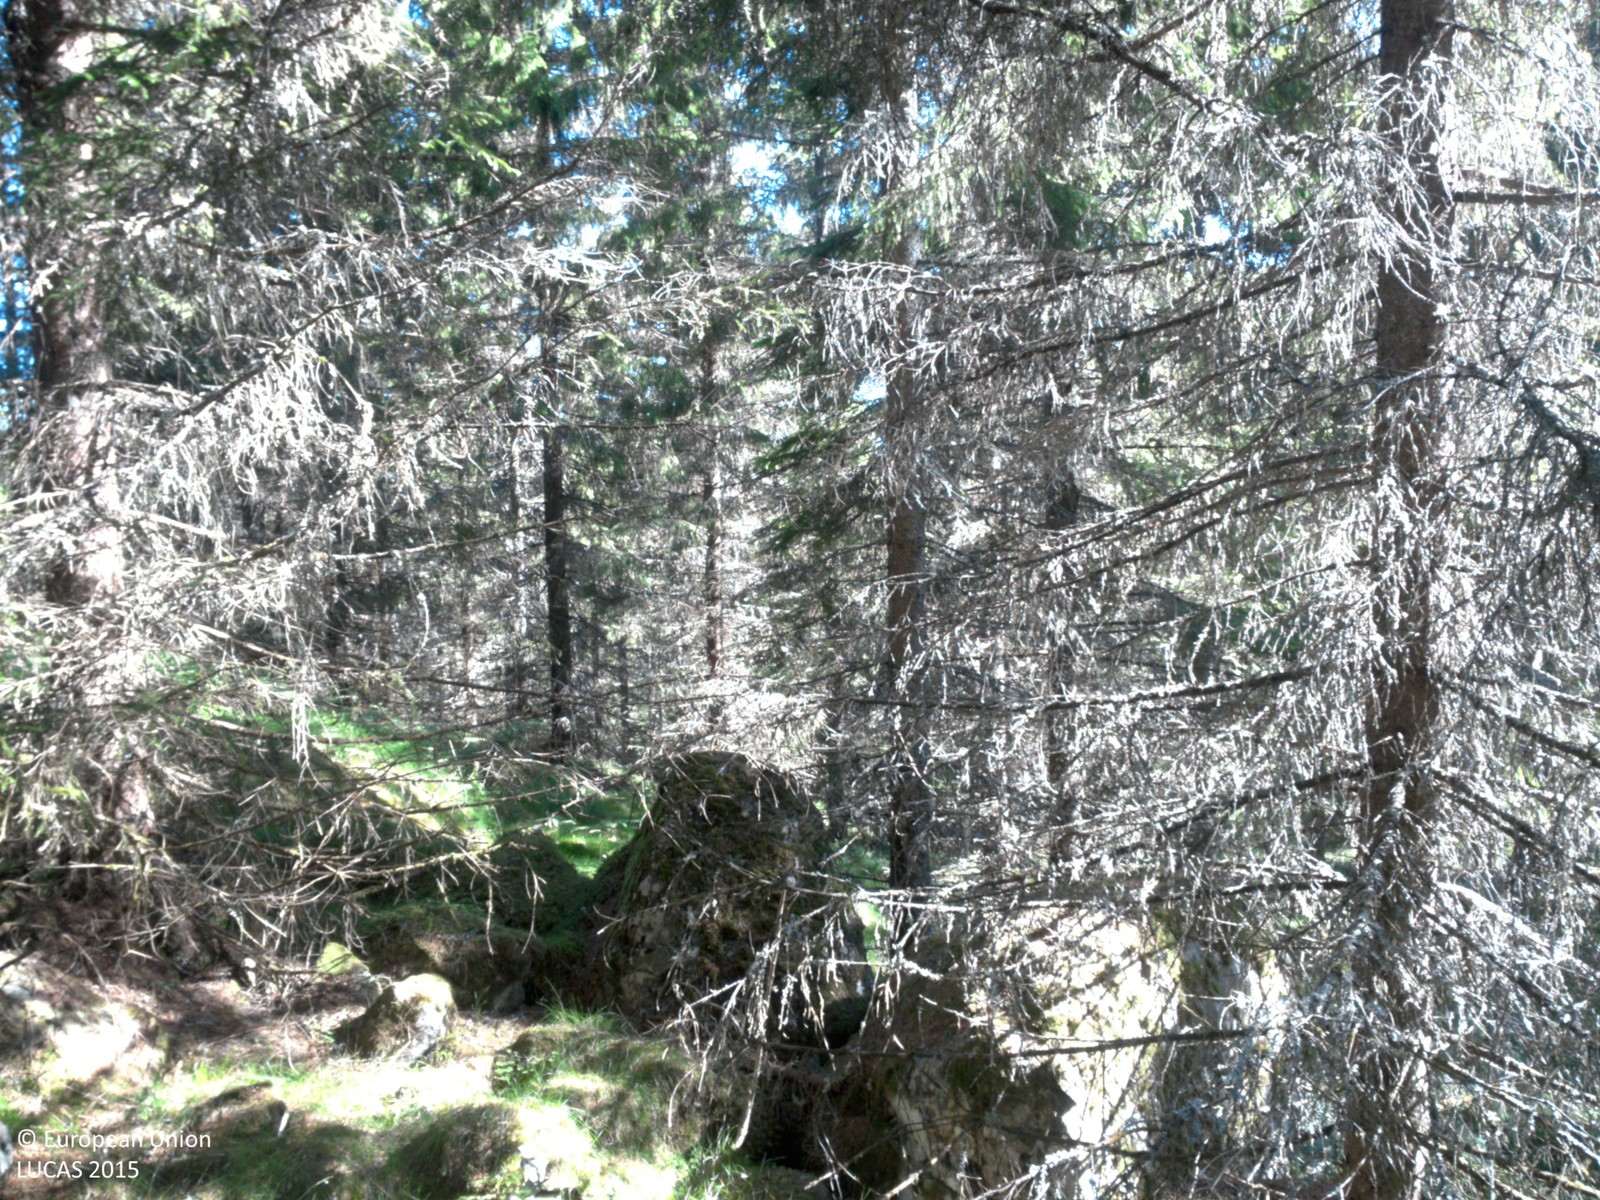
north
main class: Woodland
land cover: Spruce dominated coniferous woodland
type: boreal forest
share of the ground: > 75 %
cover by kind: coniferous forest trees 75 %, herbaceous plants 15 %, shrubs 5 %, lichens and mosses 5 %
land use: Forestry
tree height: > 5 m
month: July
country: SE
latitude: 58.8303
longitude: 12.2642
